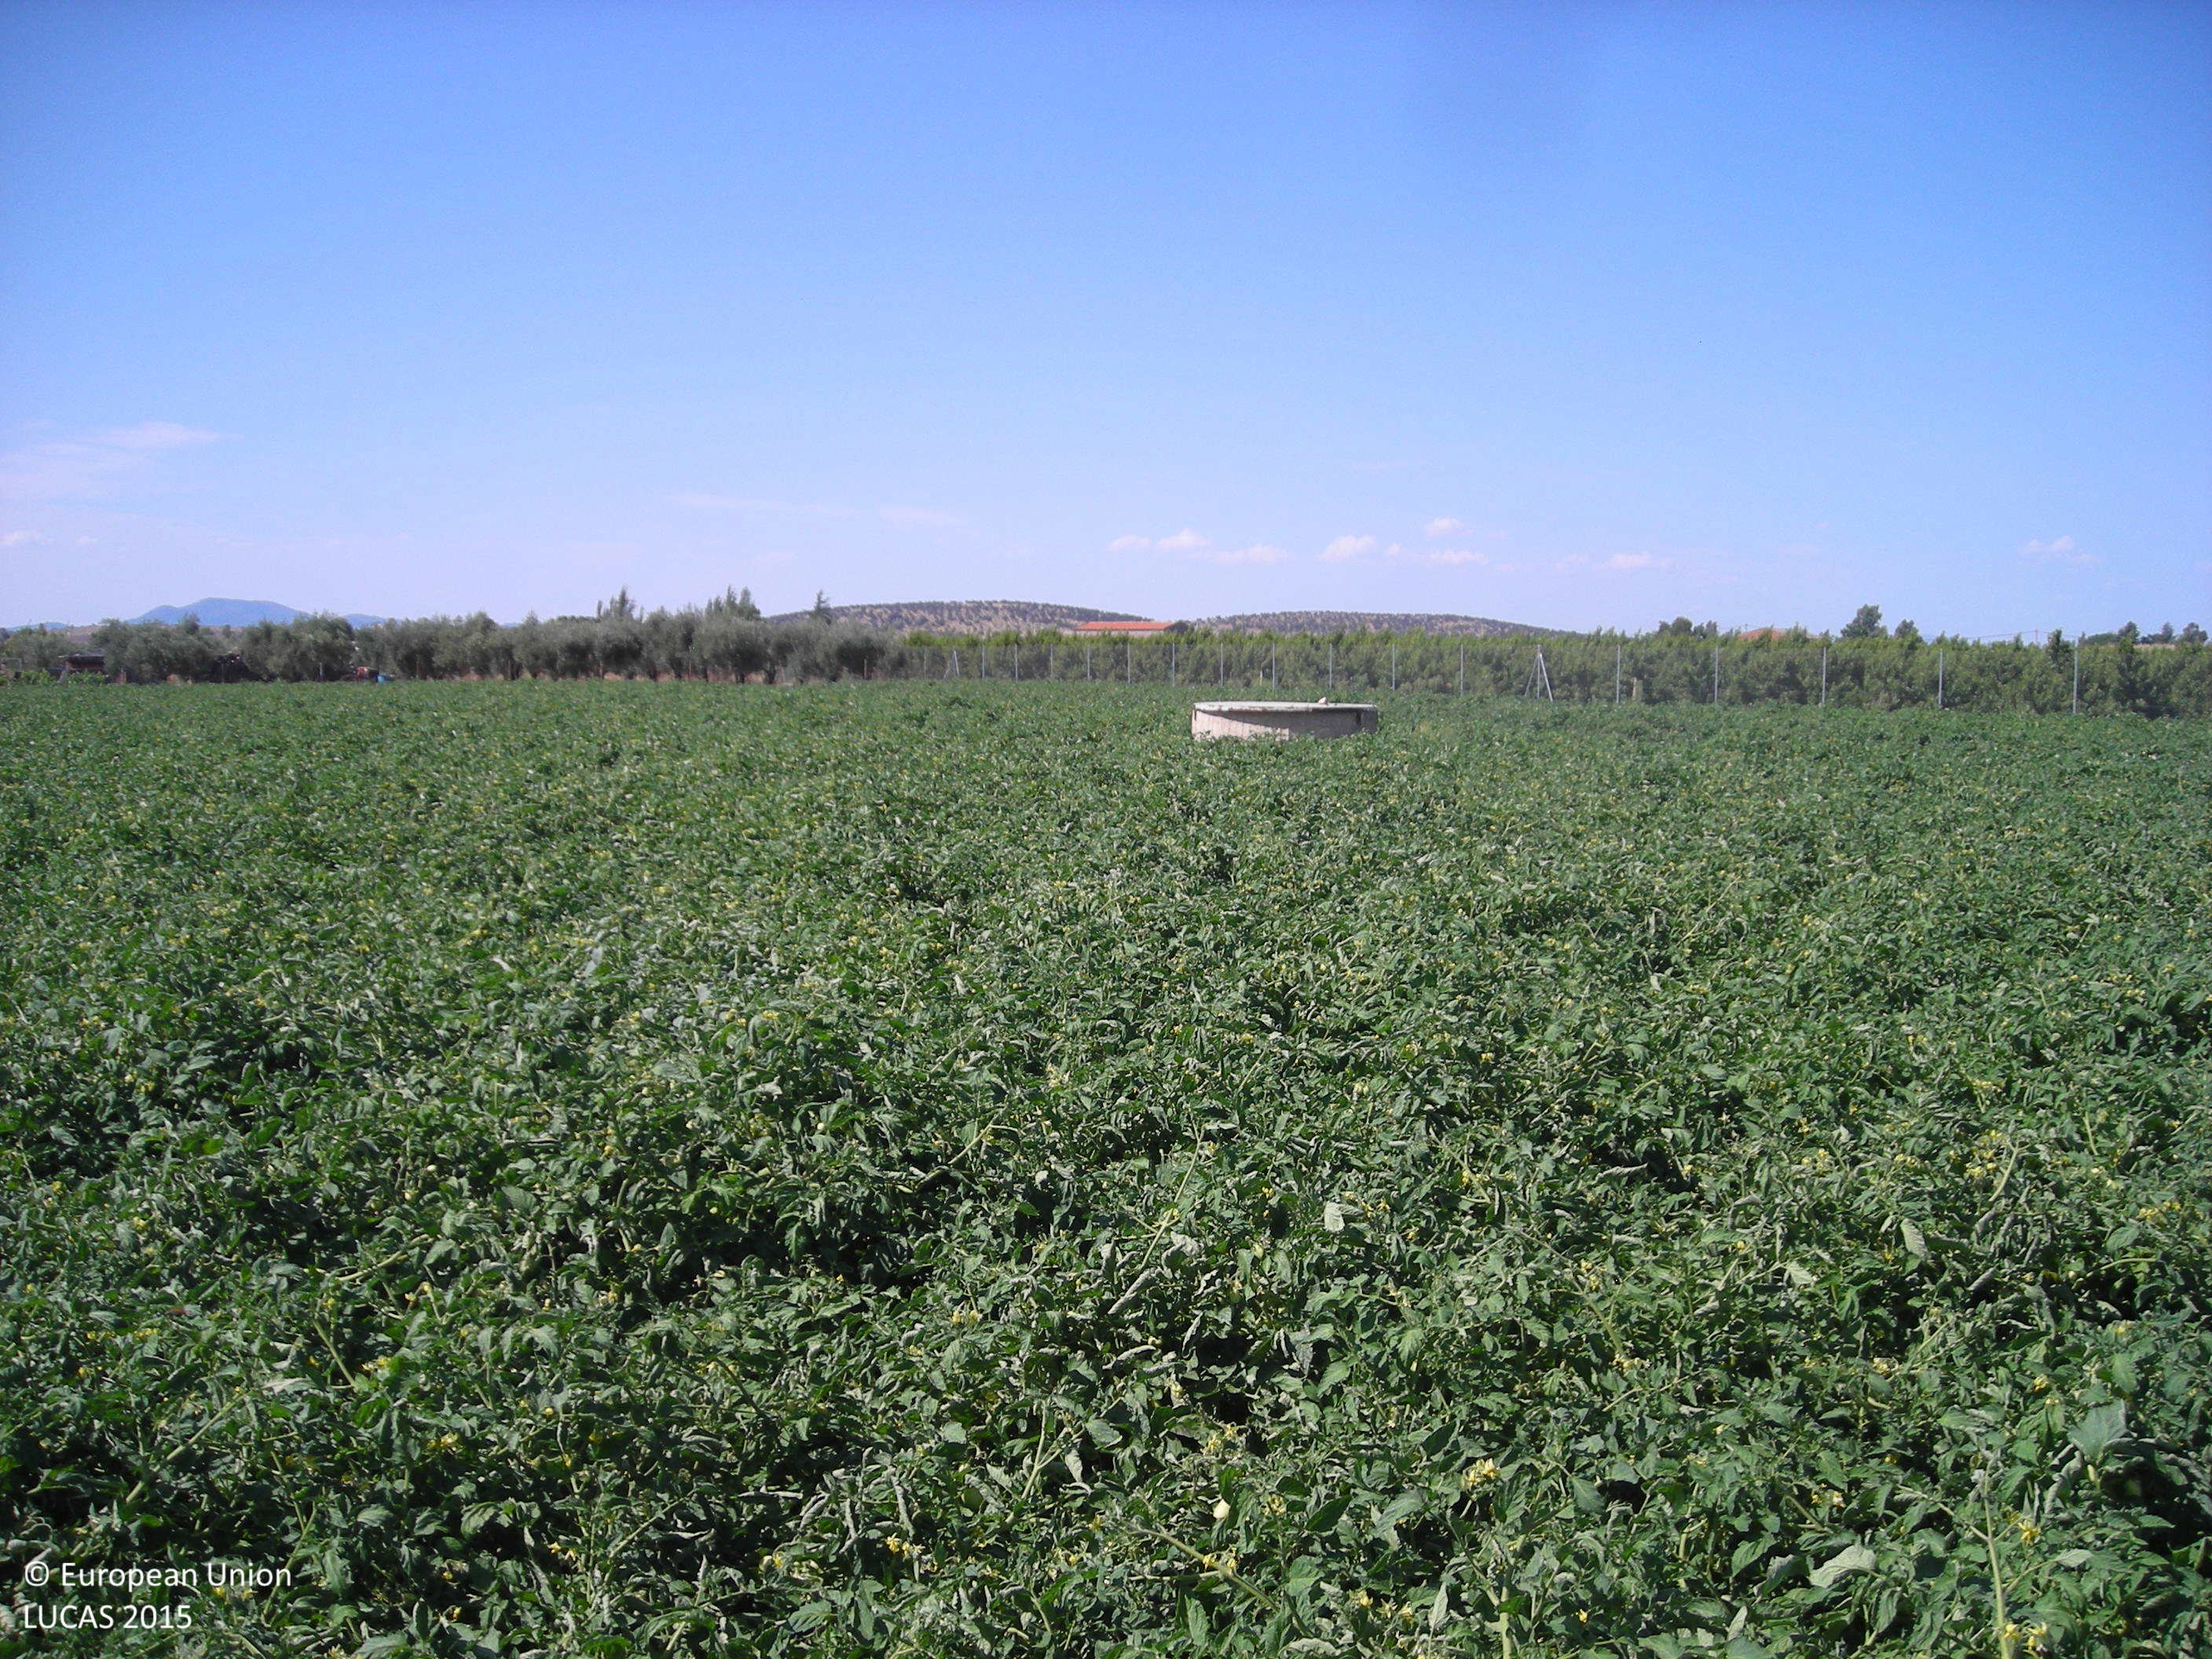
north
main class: Cropland
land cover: Tomatoes
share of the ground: > 75 %
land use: Agriculture (excluding fallow land and kitchen gardens)
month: July
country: ES
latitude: 38.9546
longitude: -5.9404
